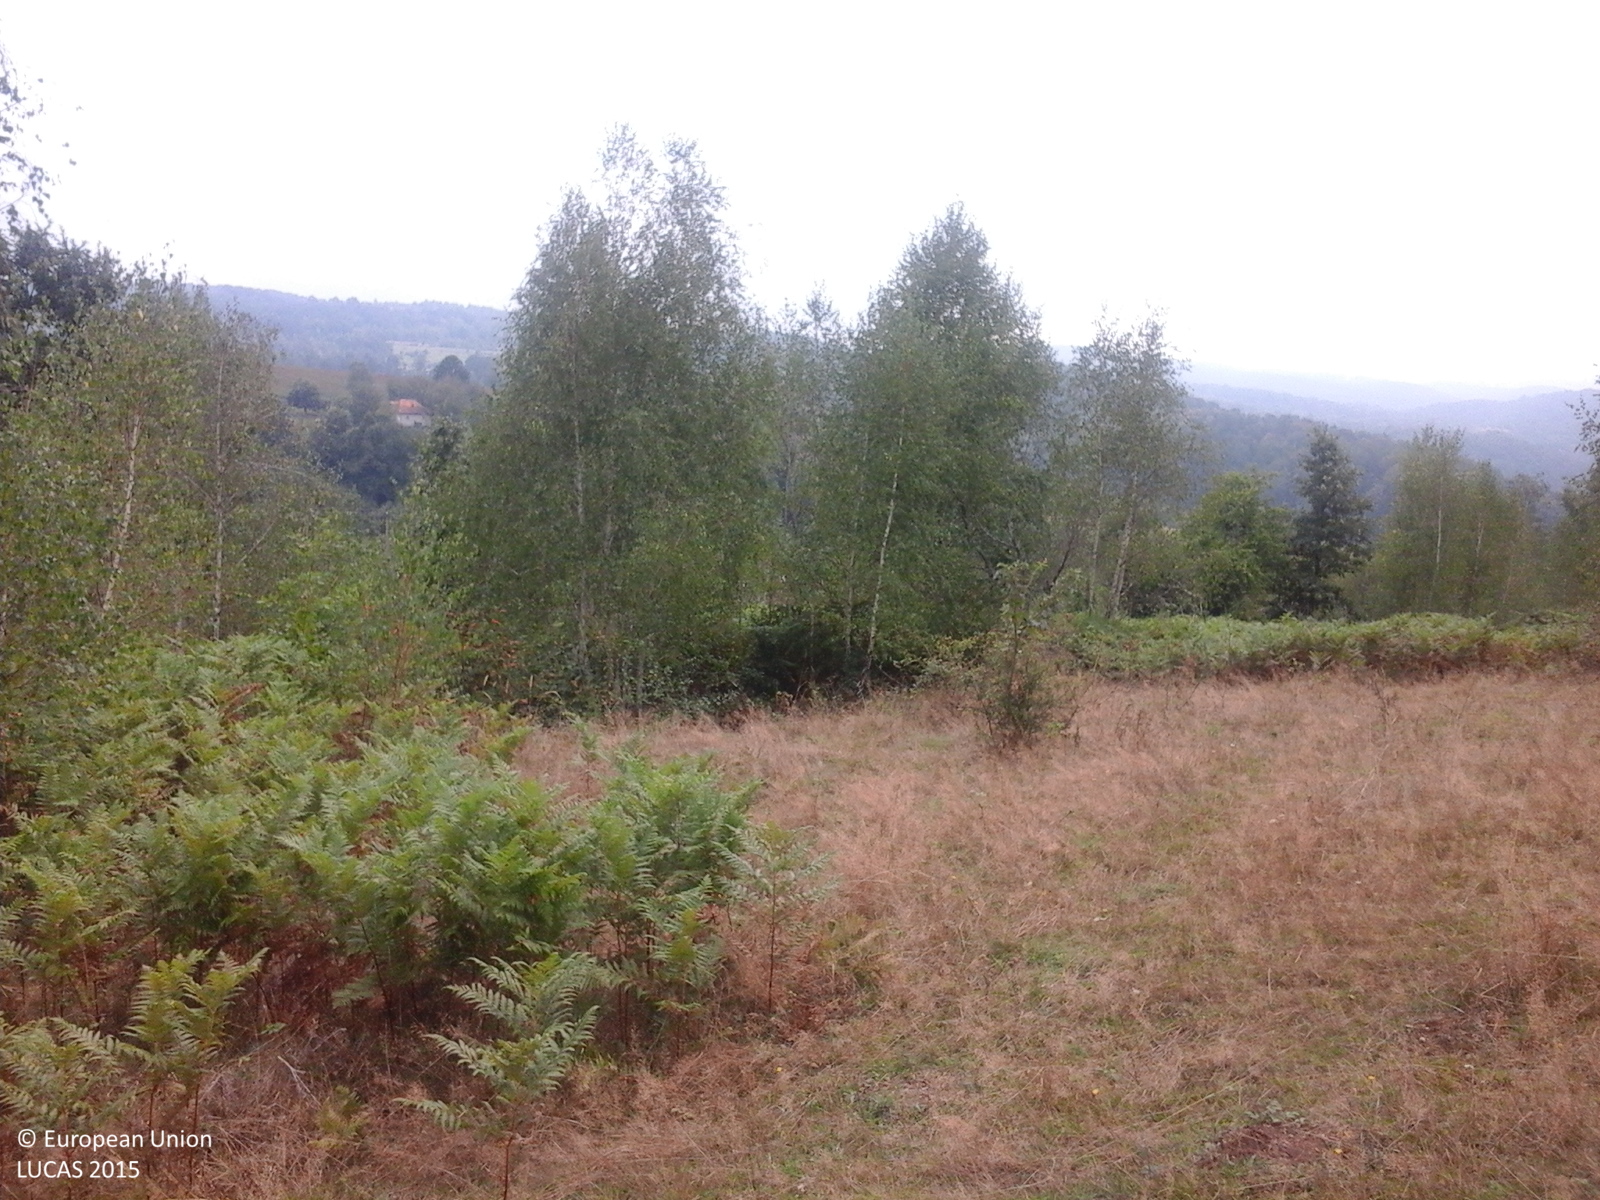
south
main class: Grassland
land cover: Grassland without tree/shrub cover
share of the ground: > 75 %
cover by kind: herbaceous plants 100 %
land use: Agriculture (excluding fallow land and kitchen gardens)
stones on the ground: < 10 %
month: September
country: RO
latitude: 46.9211
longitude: 22.5429
